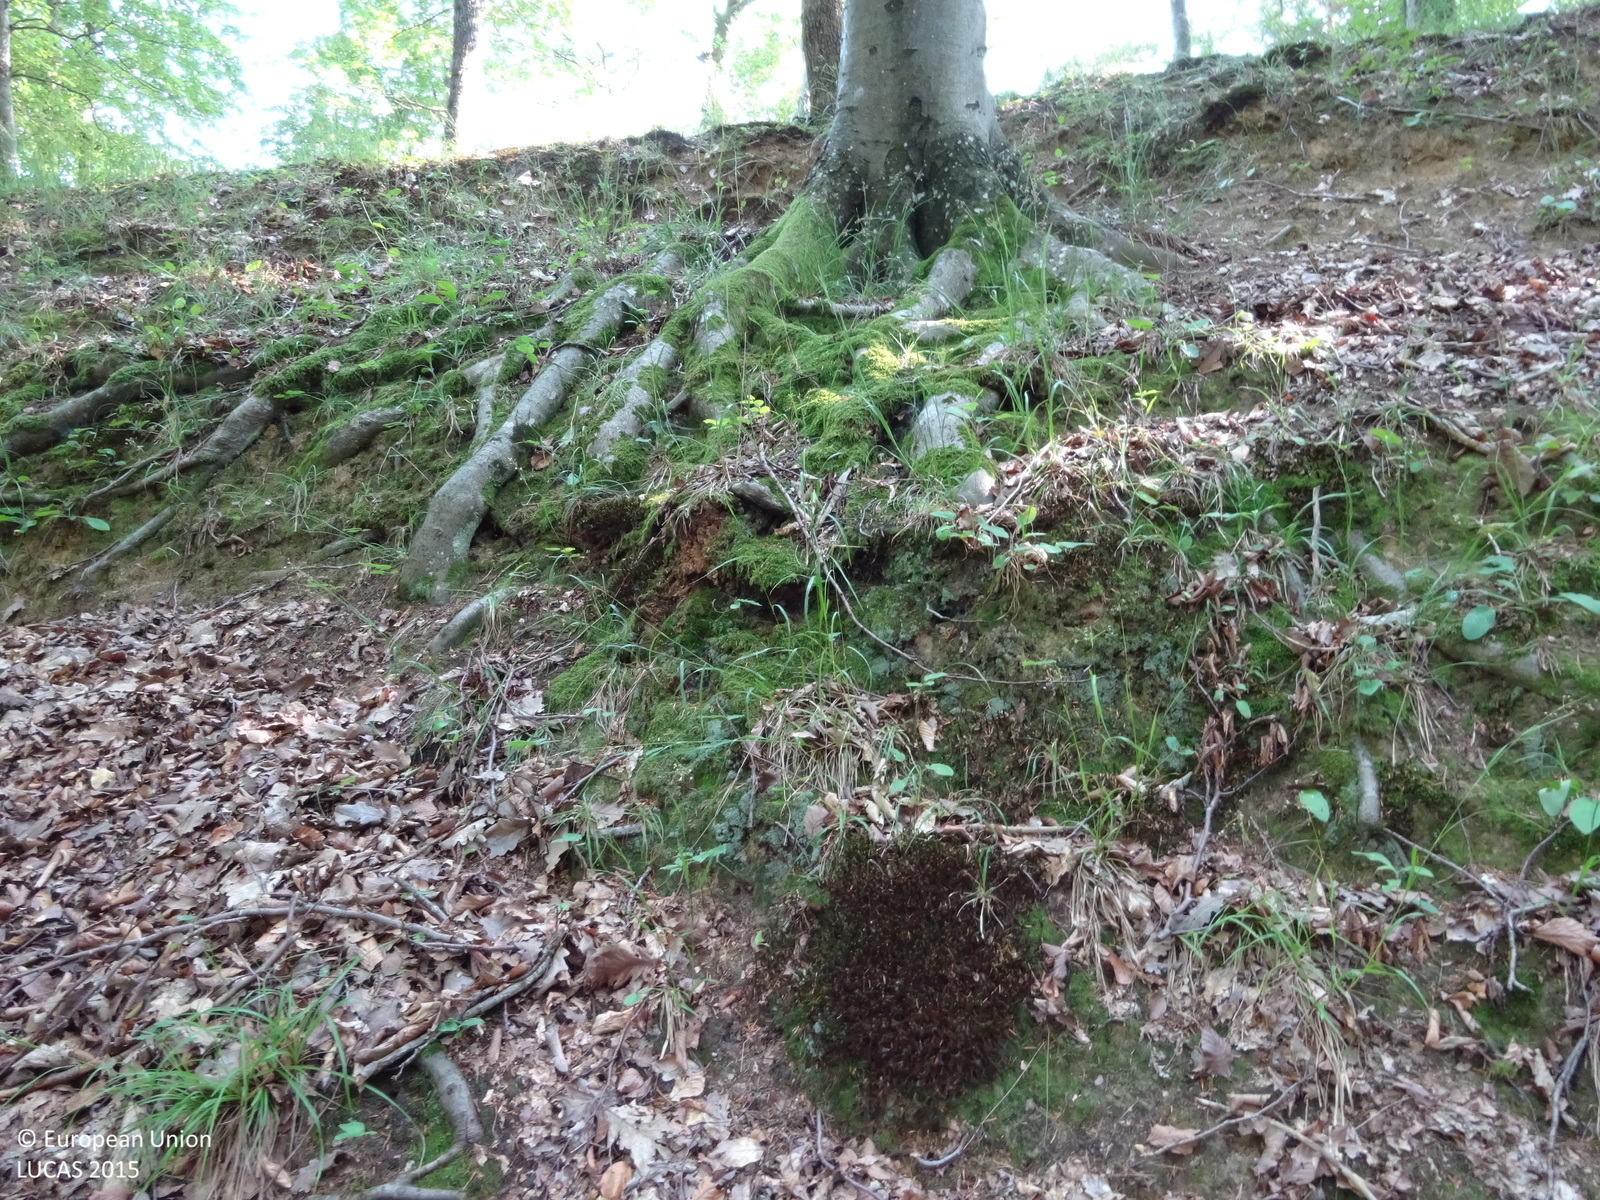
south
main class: Woodland
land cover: Broadleaved woodland
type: mountainous beech forest
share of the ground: > 75 %
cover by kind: broadleaved forest trees 100 %
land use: Forestry
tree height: > 5 m
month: July
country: AT
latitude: 46.8706
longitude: 15.9700
